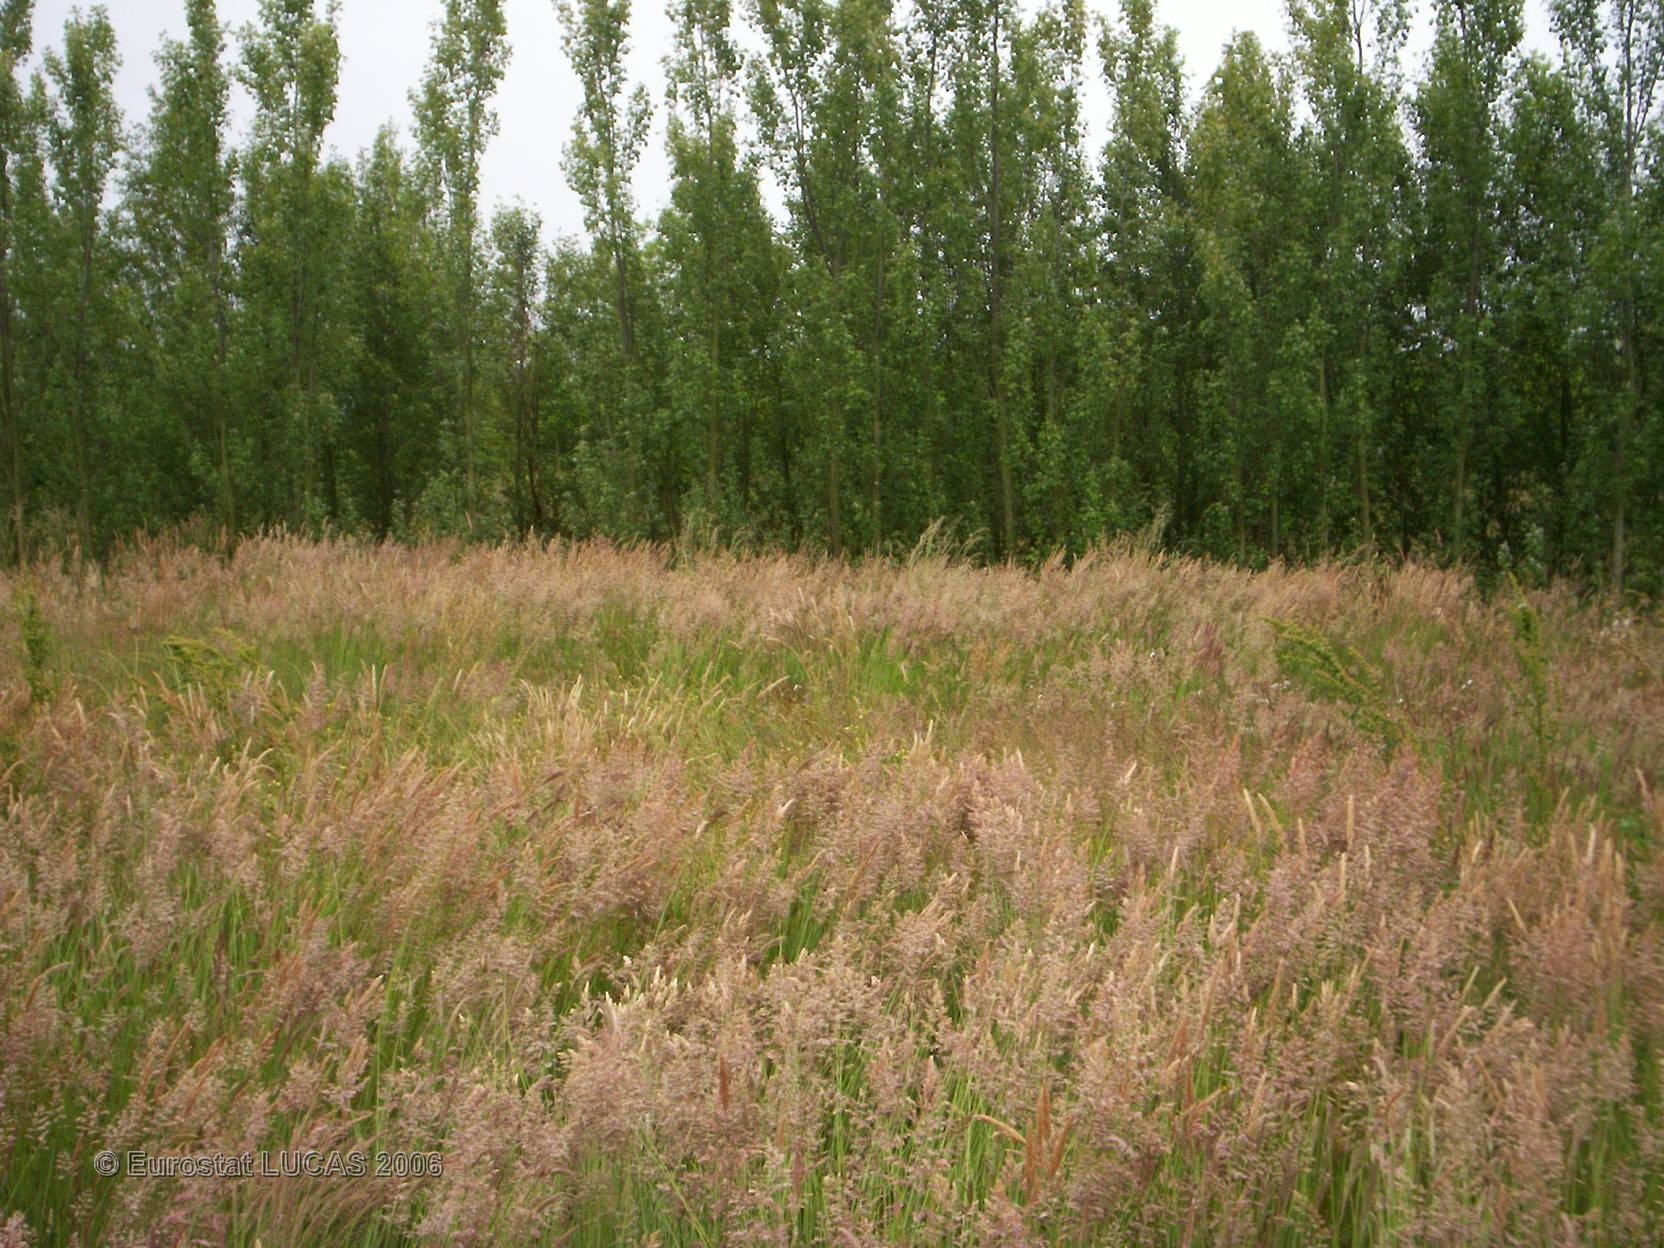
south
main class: Grassland
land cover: Grassland with sparse tree/shrub cover
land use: Agriculture (excluding fallow land and kitchen gardens)
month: May
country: FR
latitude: 45.9581
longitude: -0.8790
